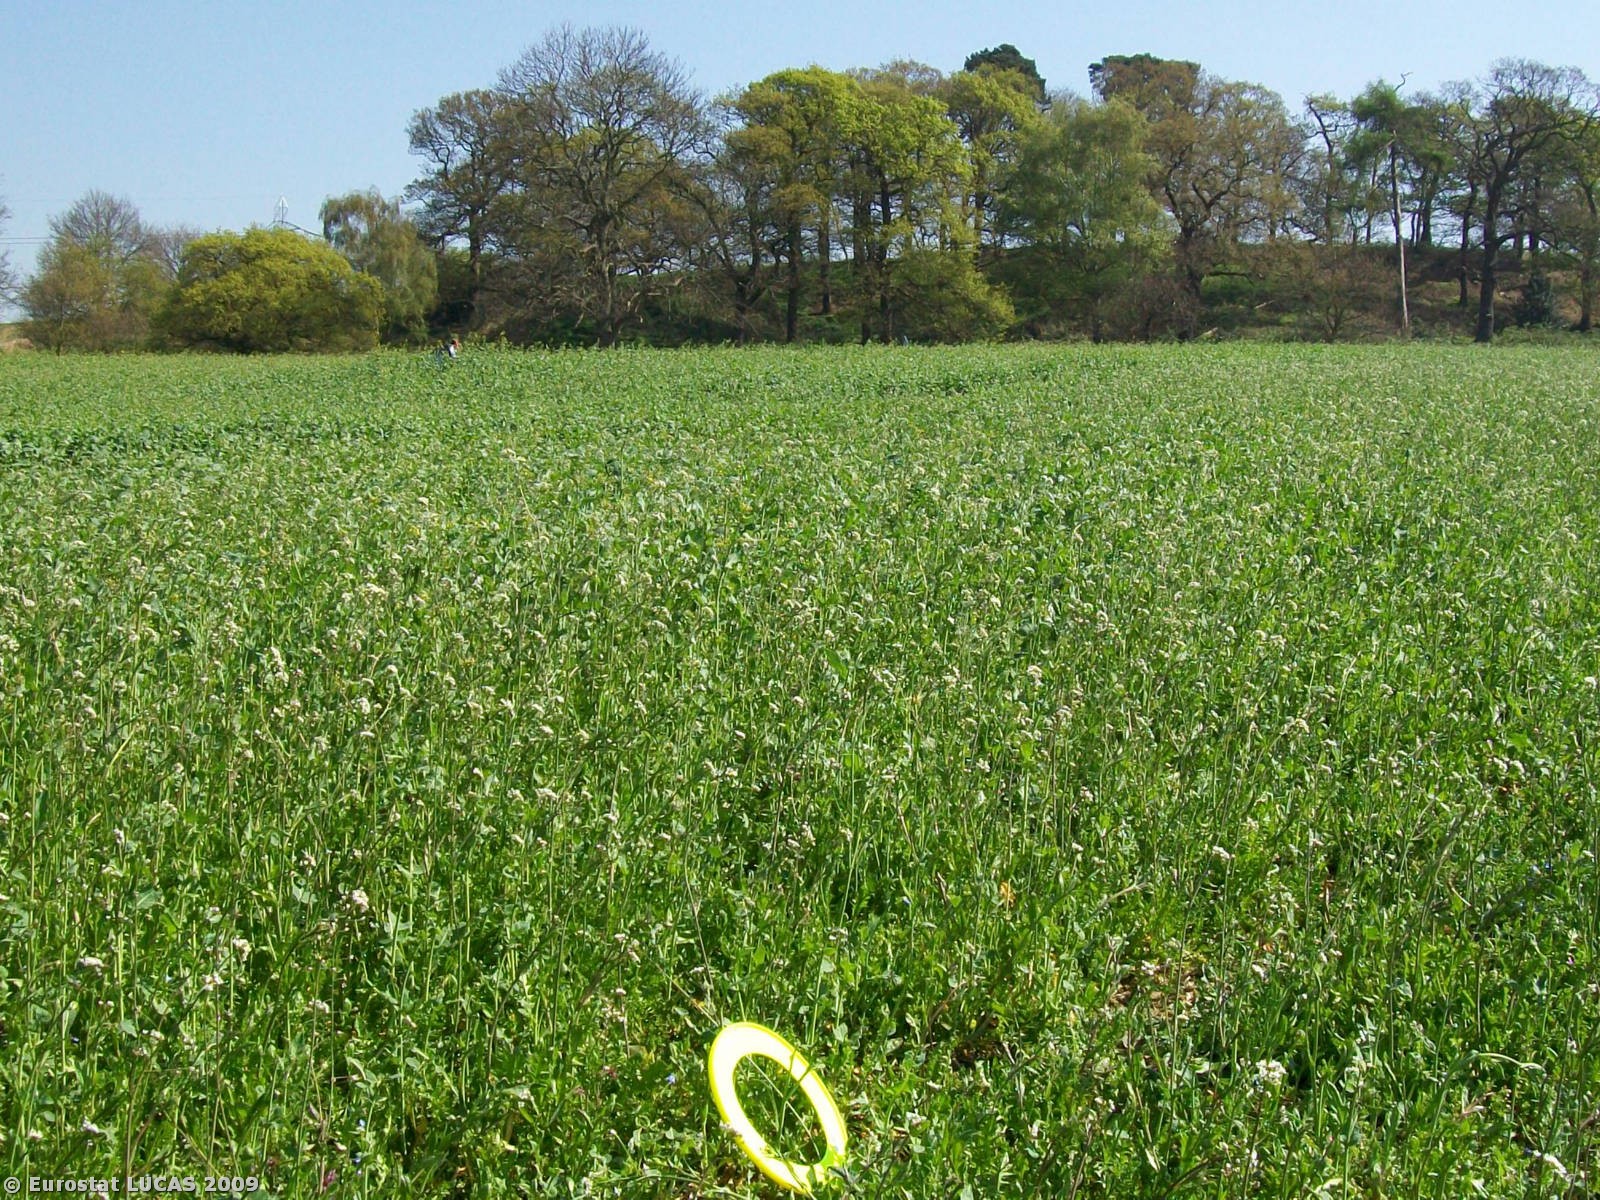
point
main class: Cropland
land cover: Rape and turnip rape
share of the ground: > 75 %
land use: Agriculture (excluding fallow land and kitchen gardens)
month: April
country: GB
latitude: 52.8371
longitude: -1.4658
